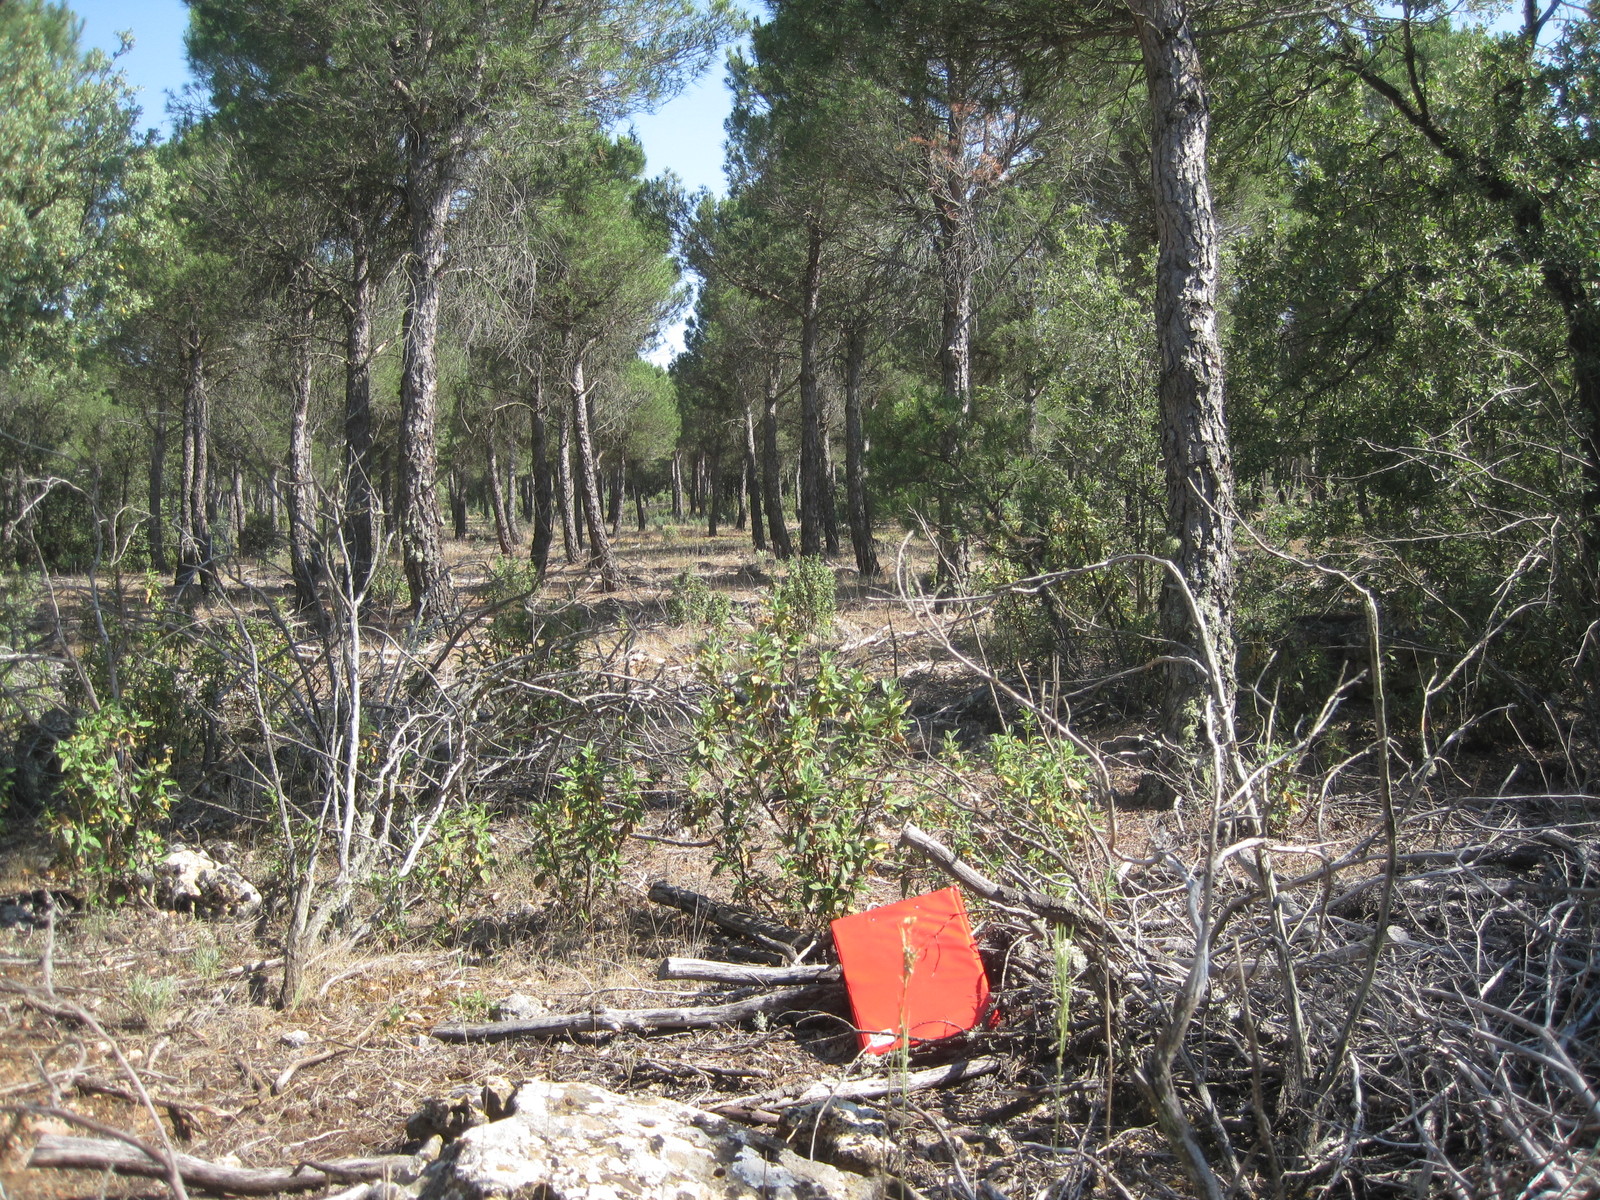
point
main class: Woodland
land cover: Pine dominated mixed woodland
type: coniferous forest of the mediterranean region
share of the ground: > 75 %
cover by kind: coniferous forest trees 50 %, broadleaved forest trees 30 %, herbaceous plants 20 %
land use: Forestry
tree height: > 5 m
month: July
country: ES
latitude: 41.8843
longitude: -4.7138
